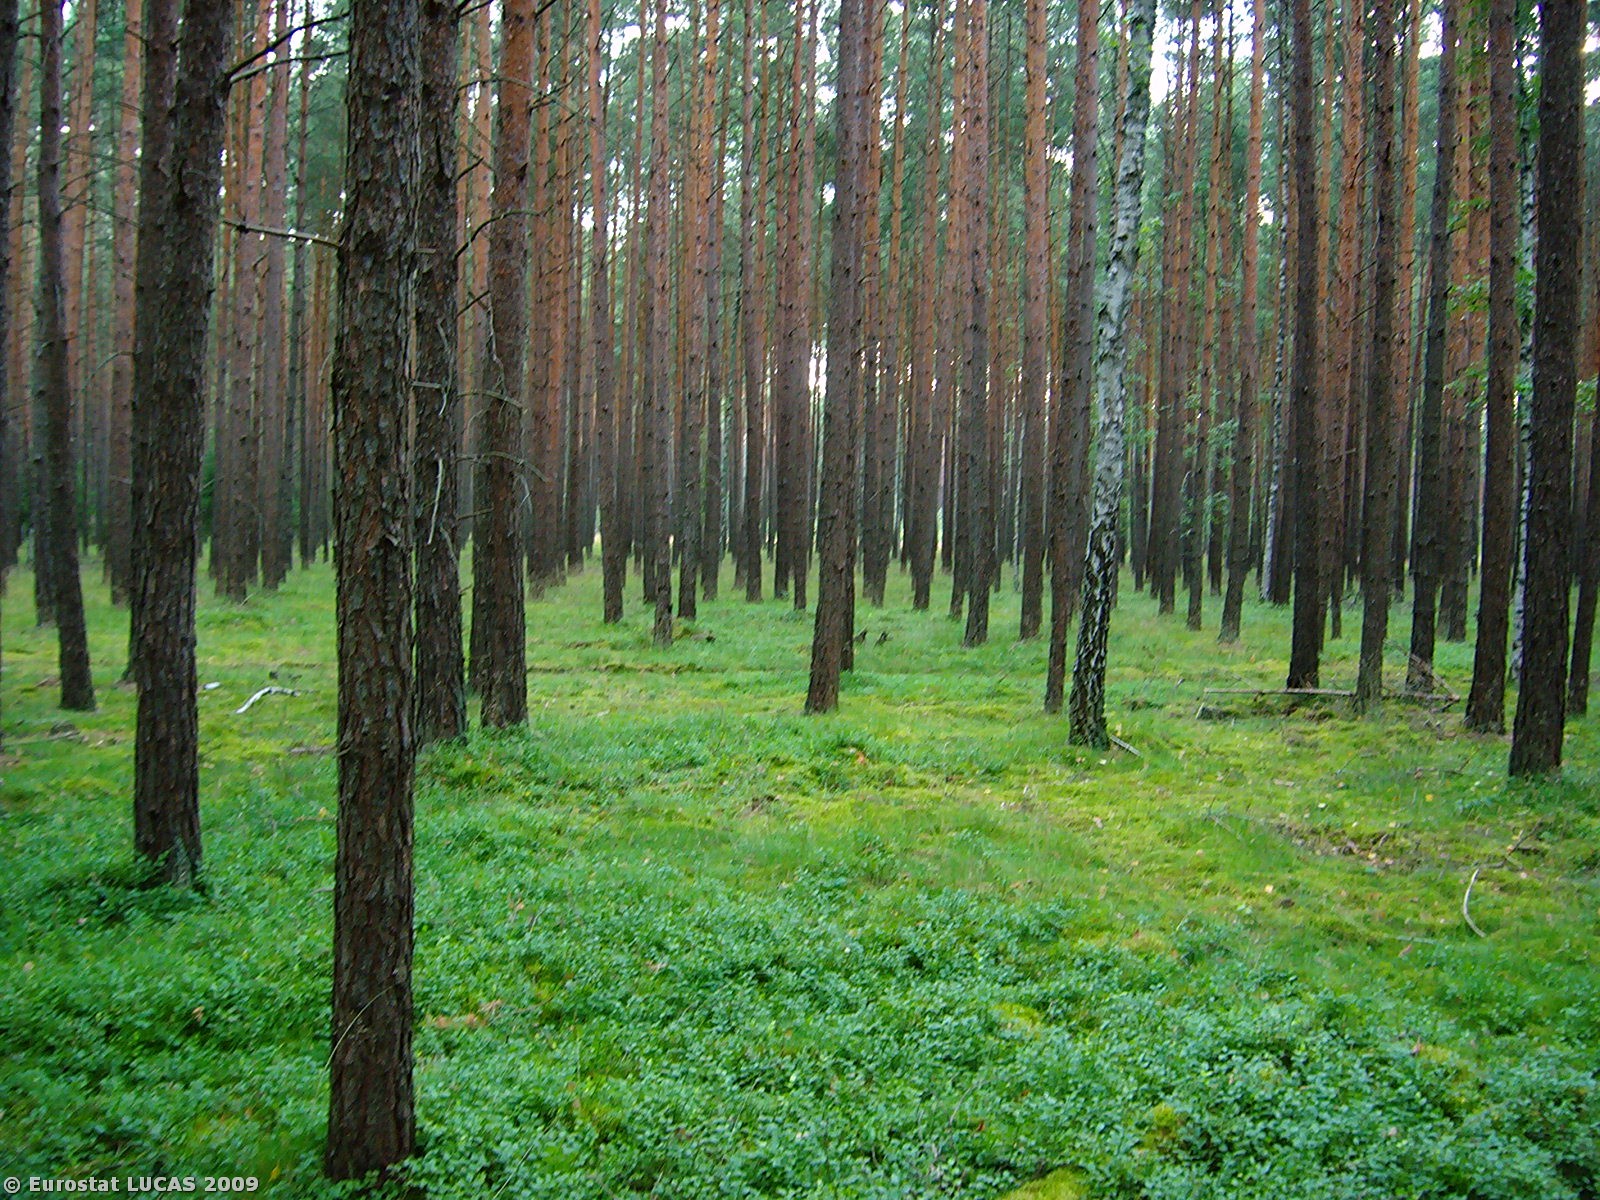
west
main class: Woodland
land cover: Mixed woodland
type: hemiboreal forest and nemoral coniferous forest and mixed broadleaved-coniferous forest
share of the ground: 50 - 75 %
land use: Forestry
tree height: > 5 m
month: July
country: PL
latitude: 52.2621
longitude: 15.2339
